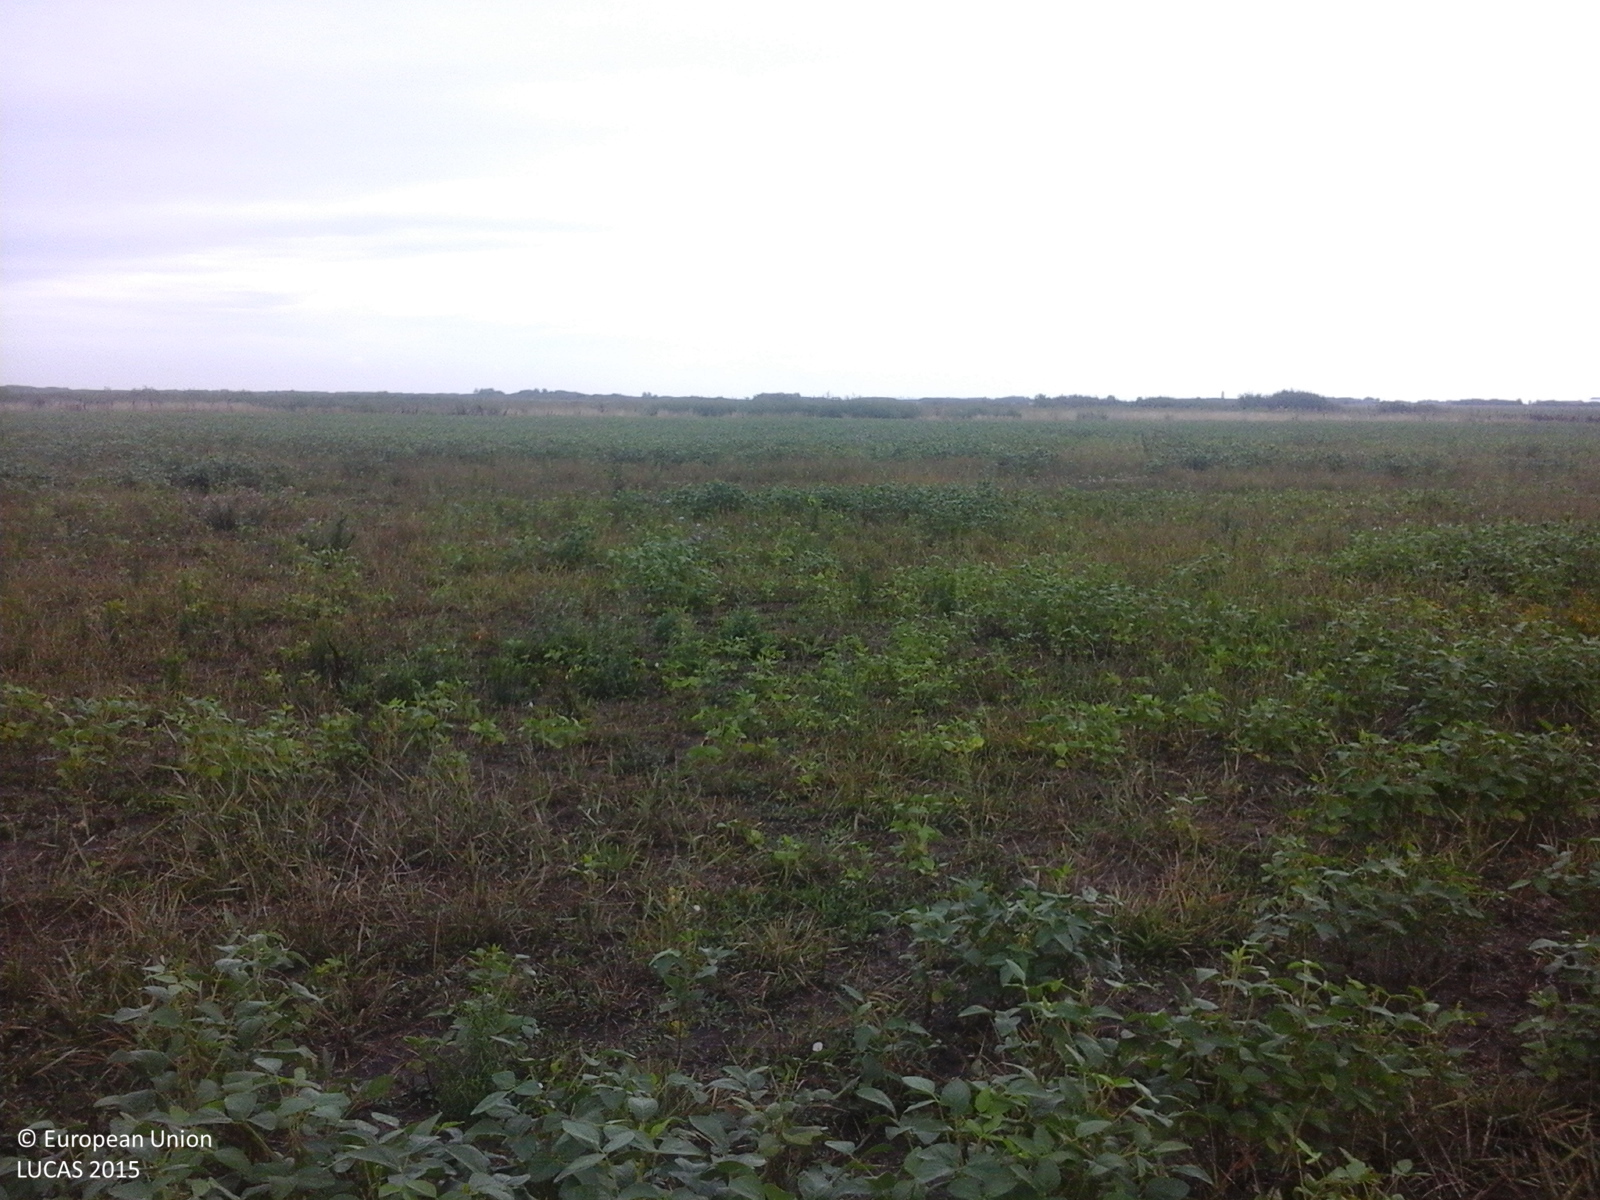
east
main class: Cropland
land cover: Soya
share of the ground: > 75 %
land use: Agriculture (excluding fallow land and kitchen gardens)
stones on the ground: < 10 %
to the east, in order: Soya; Spontaneously vegetated surfaces; Sunflower
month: August
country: RO
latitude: 45.3853
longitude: 20.9710
